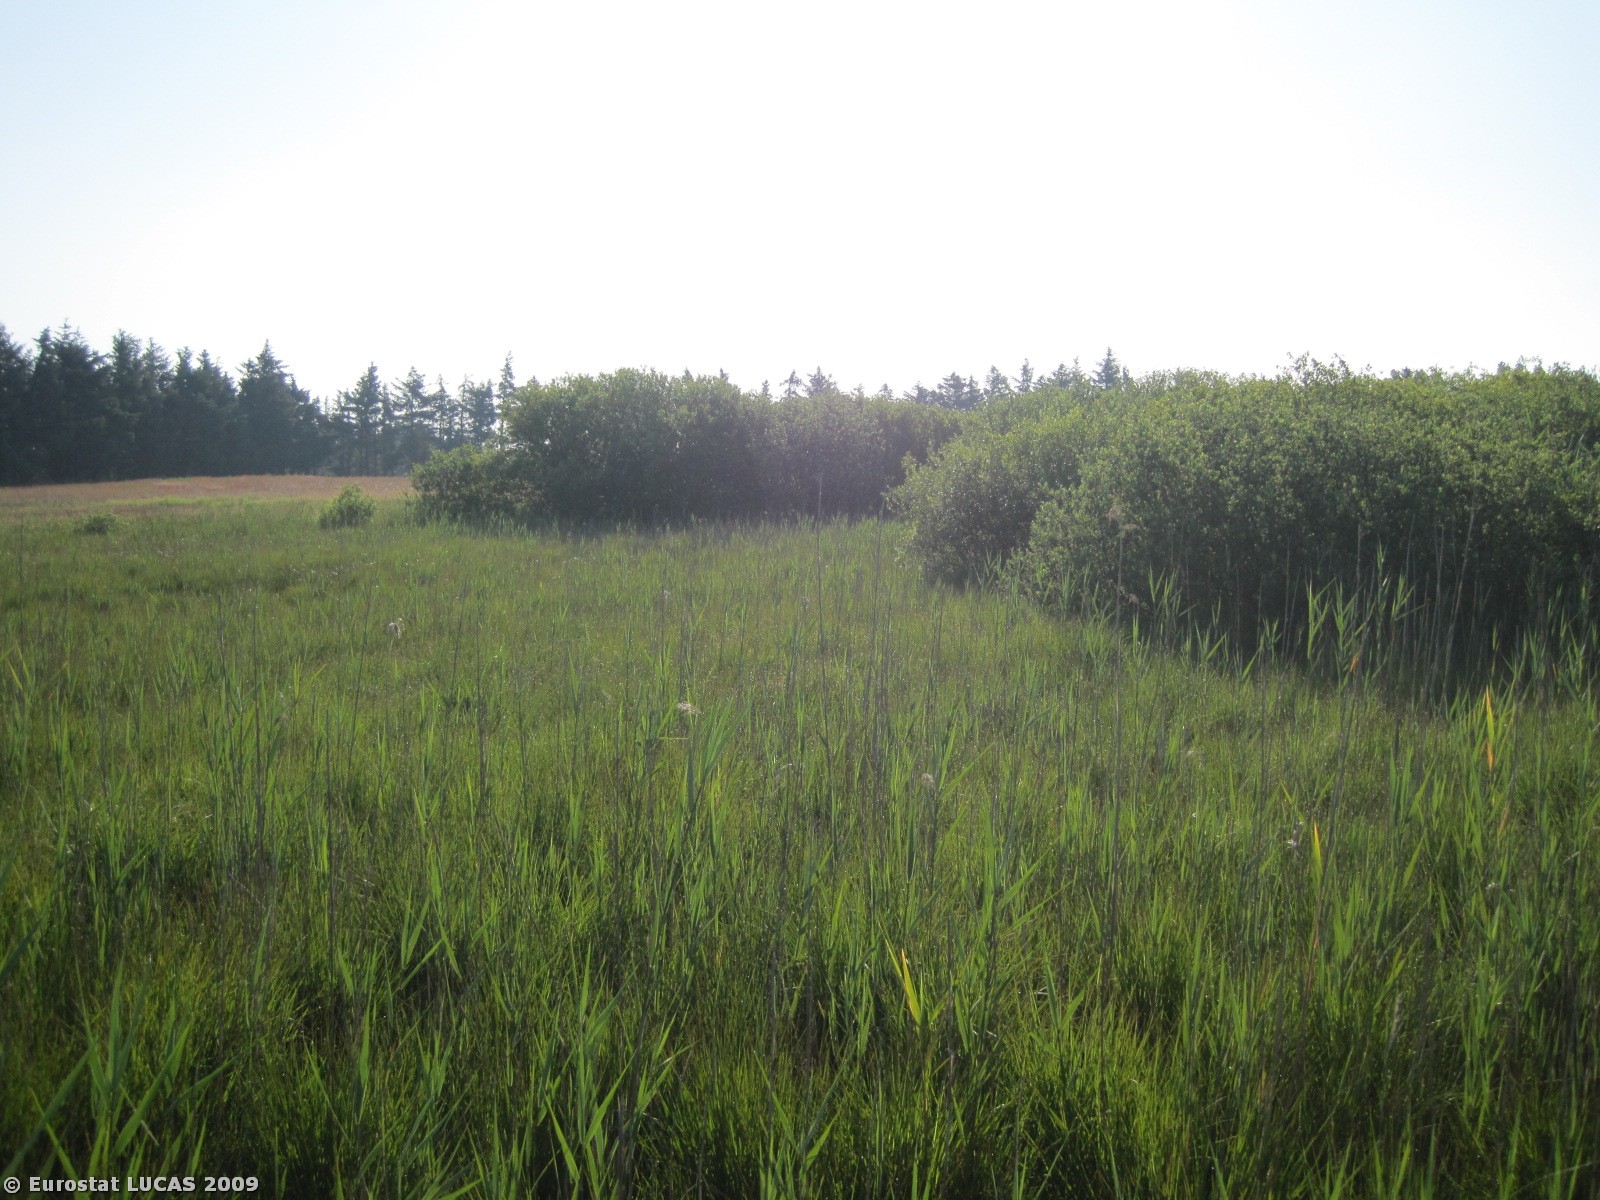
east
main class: Wetlands
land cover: Inland marshes
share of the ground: > 75 %
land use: Unused
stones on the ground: < 10 %
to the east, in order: Inland marshes; Grassland without tree/shrub cover; Shrubland without tree cover; Grassland without tree/shrub cover; Coniferous woodland; Grass margins; Tracks; Grass margins; Barley
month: July
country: DK
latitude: 56.3739
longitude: 8.2695
